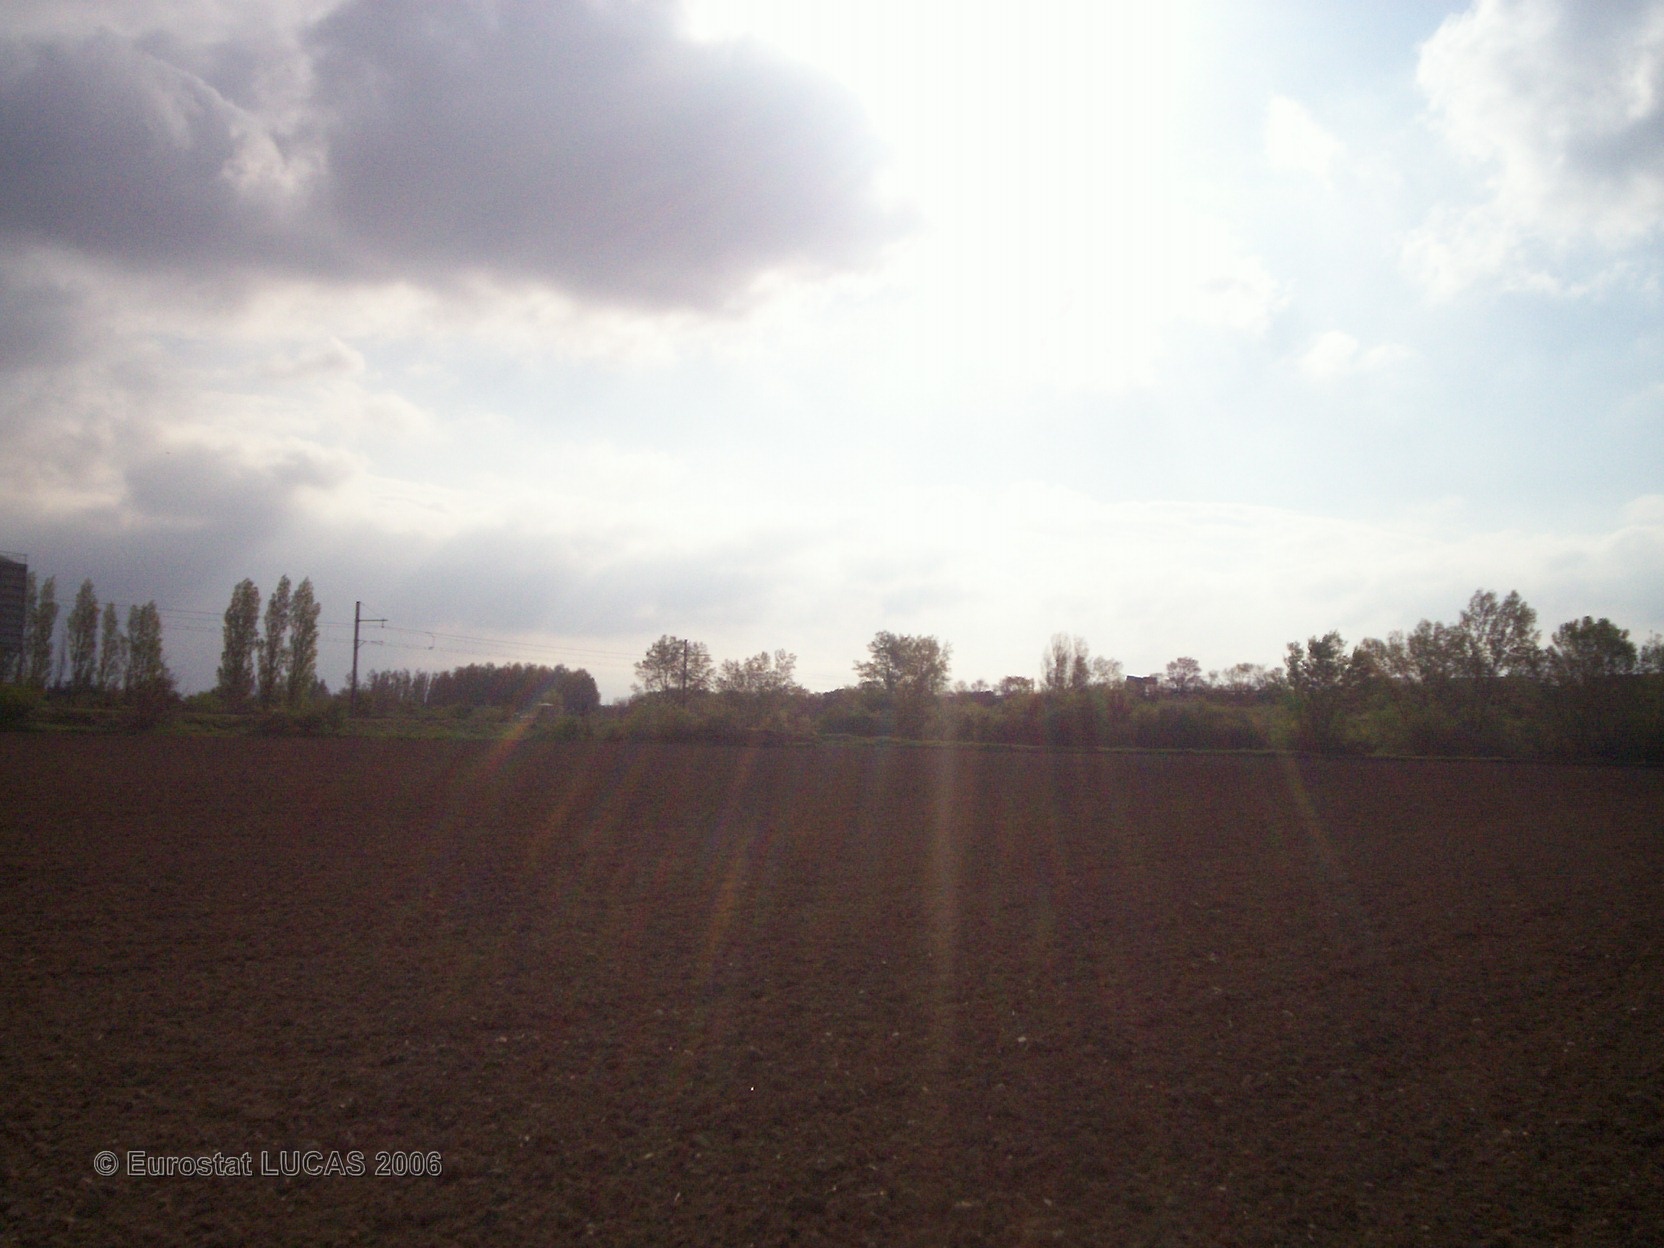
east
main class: Cropland
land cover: Sunflower
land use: Agriculture (excluding fallow land and kitchen gardens)
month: June
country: FR
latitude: 44.7809
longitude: 4.8120
